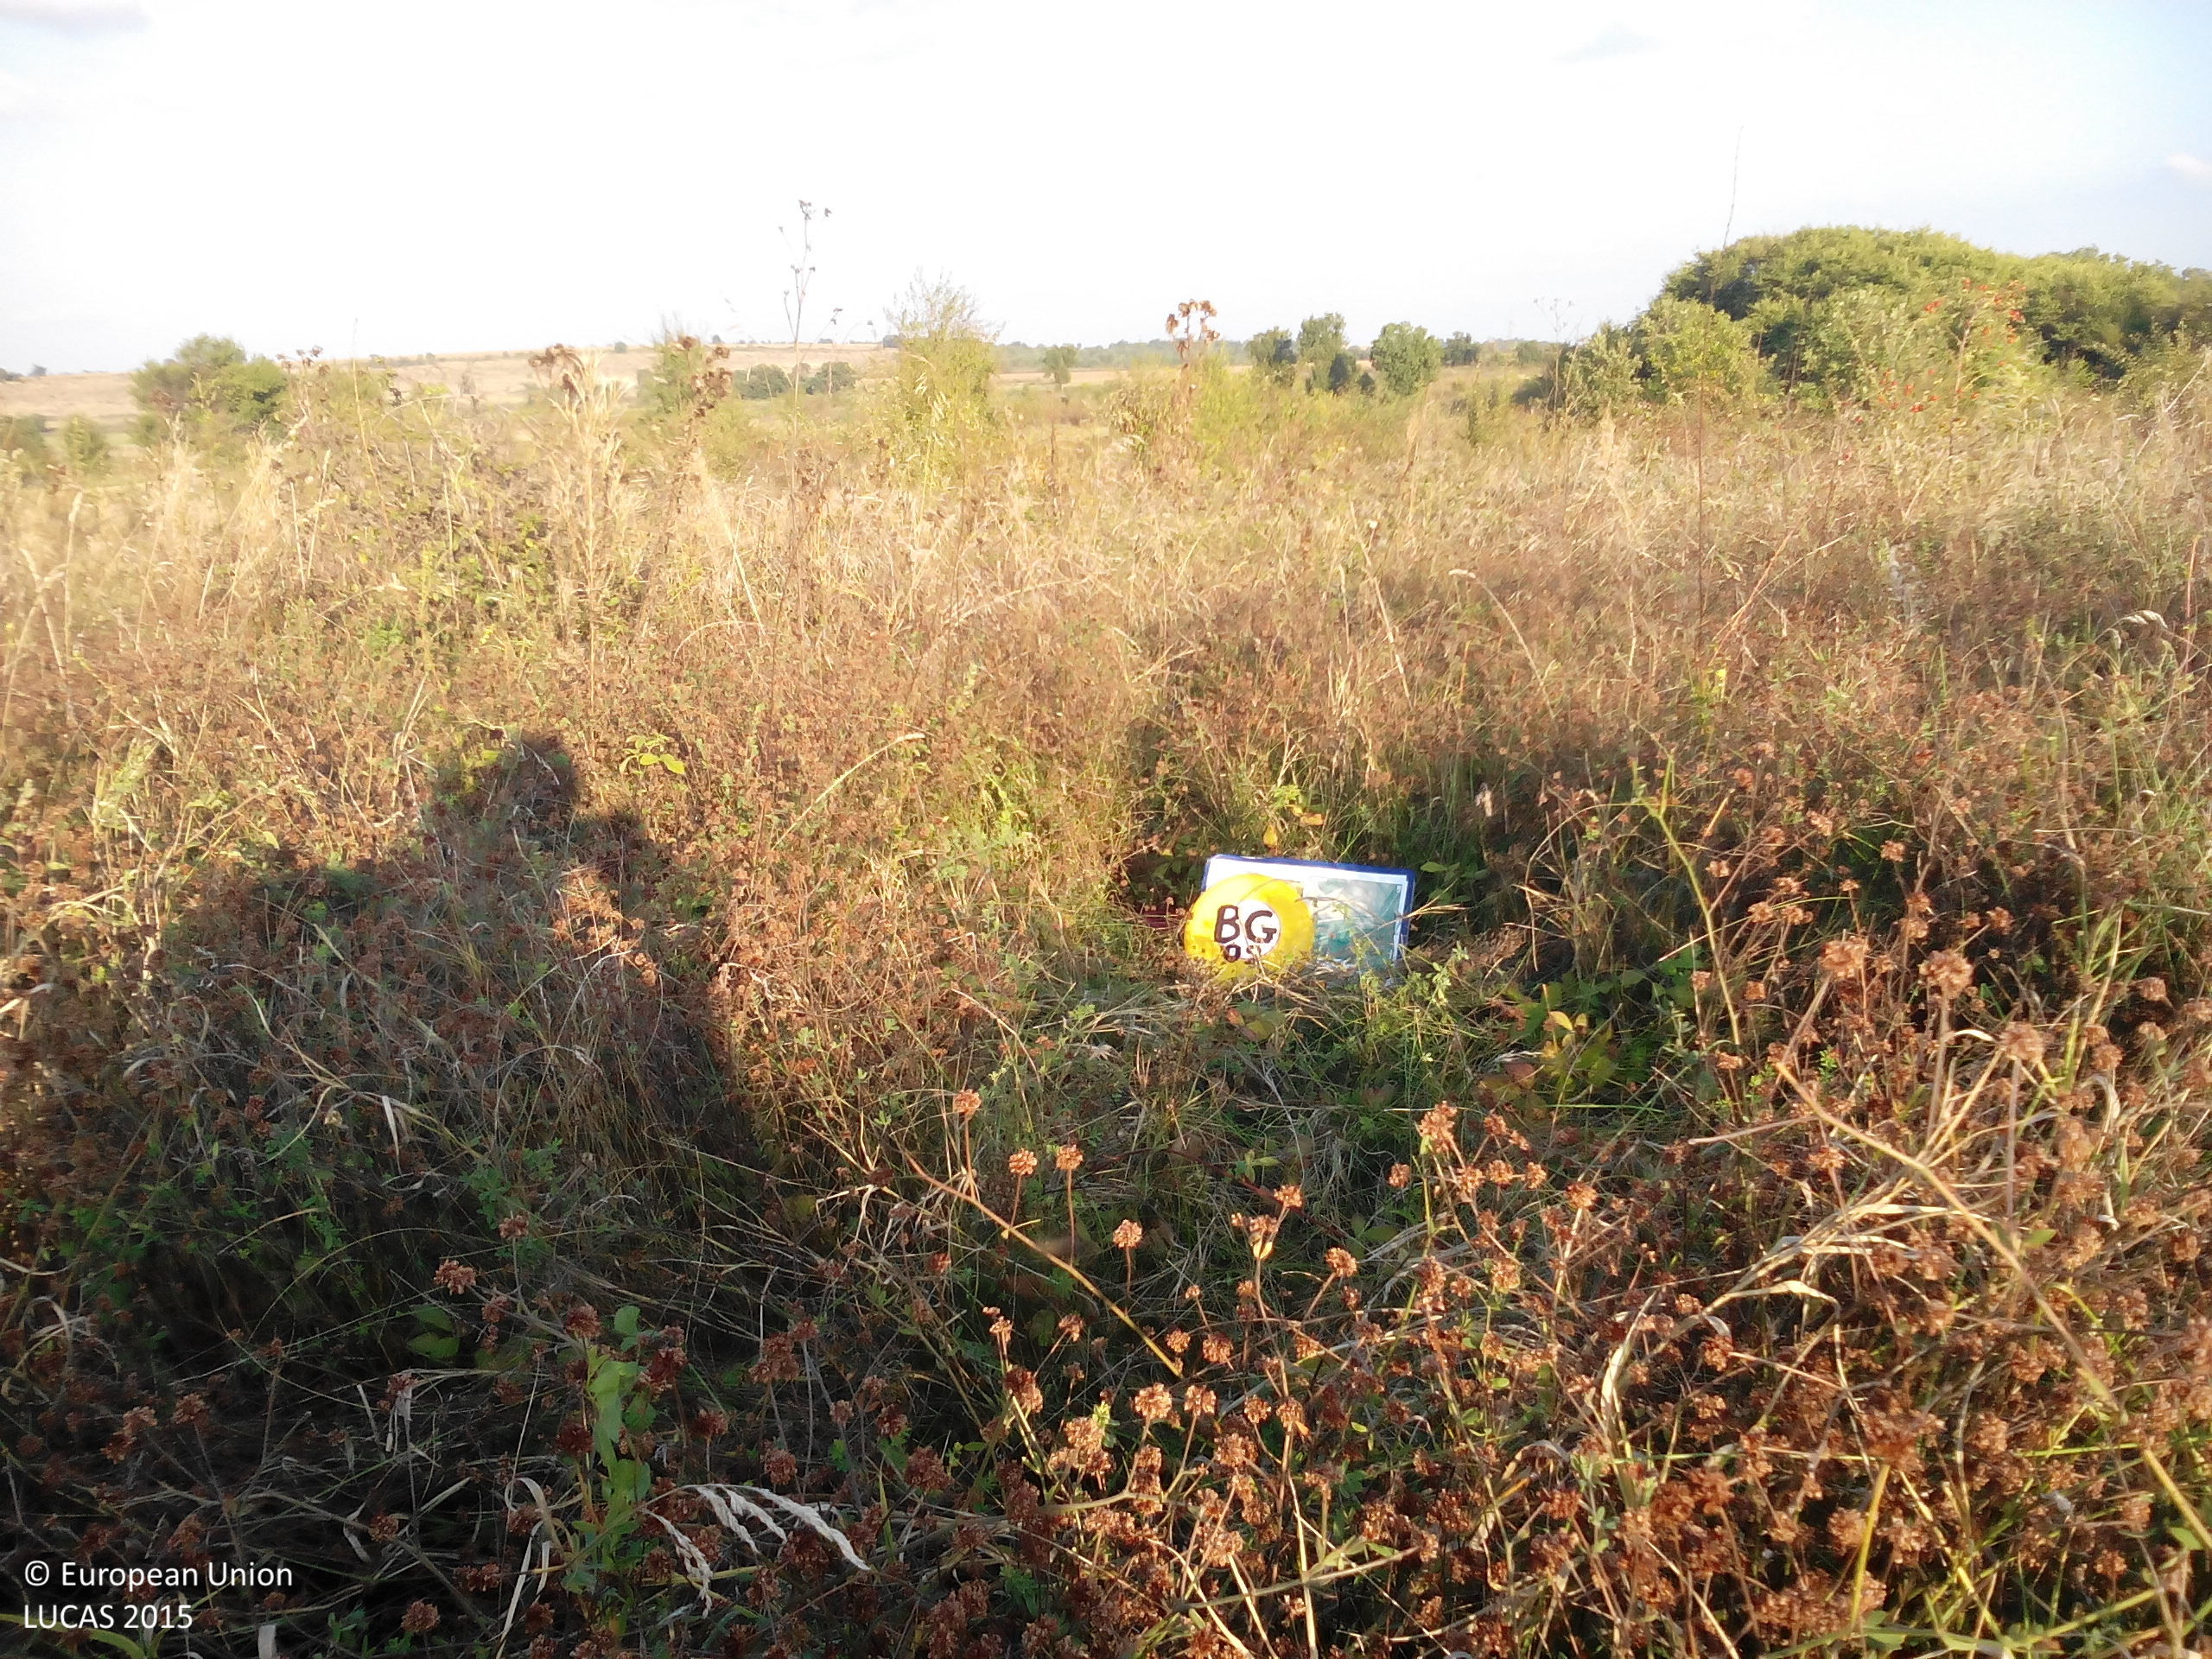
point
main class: Grassland
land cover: Grassland without tree/shrub cover
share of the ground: > 75 %
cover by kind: herbaceous plants 100 %
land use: Abandoned areas
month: October
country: BG
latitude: 43.2591
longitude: 23.9324
